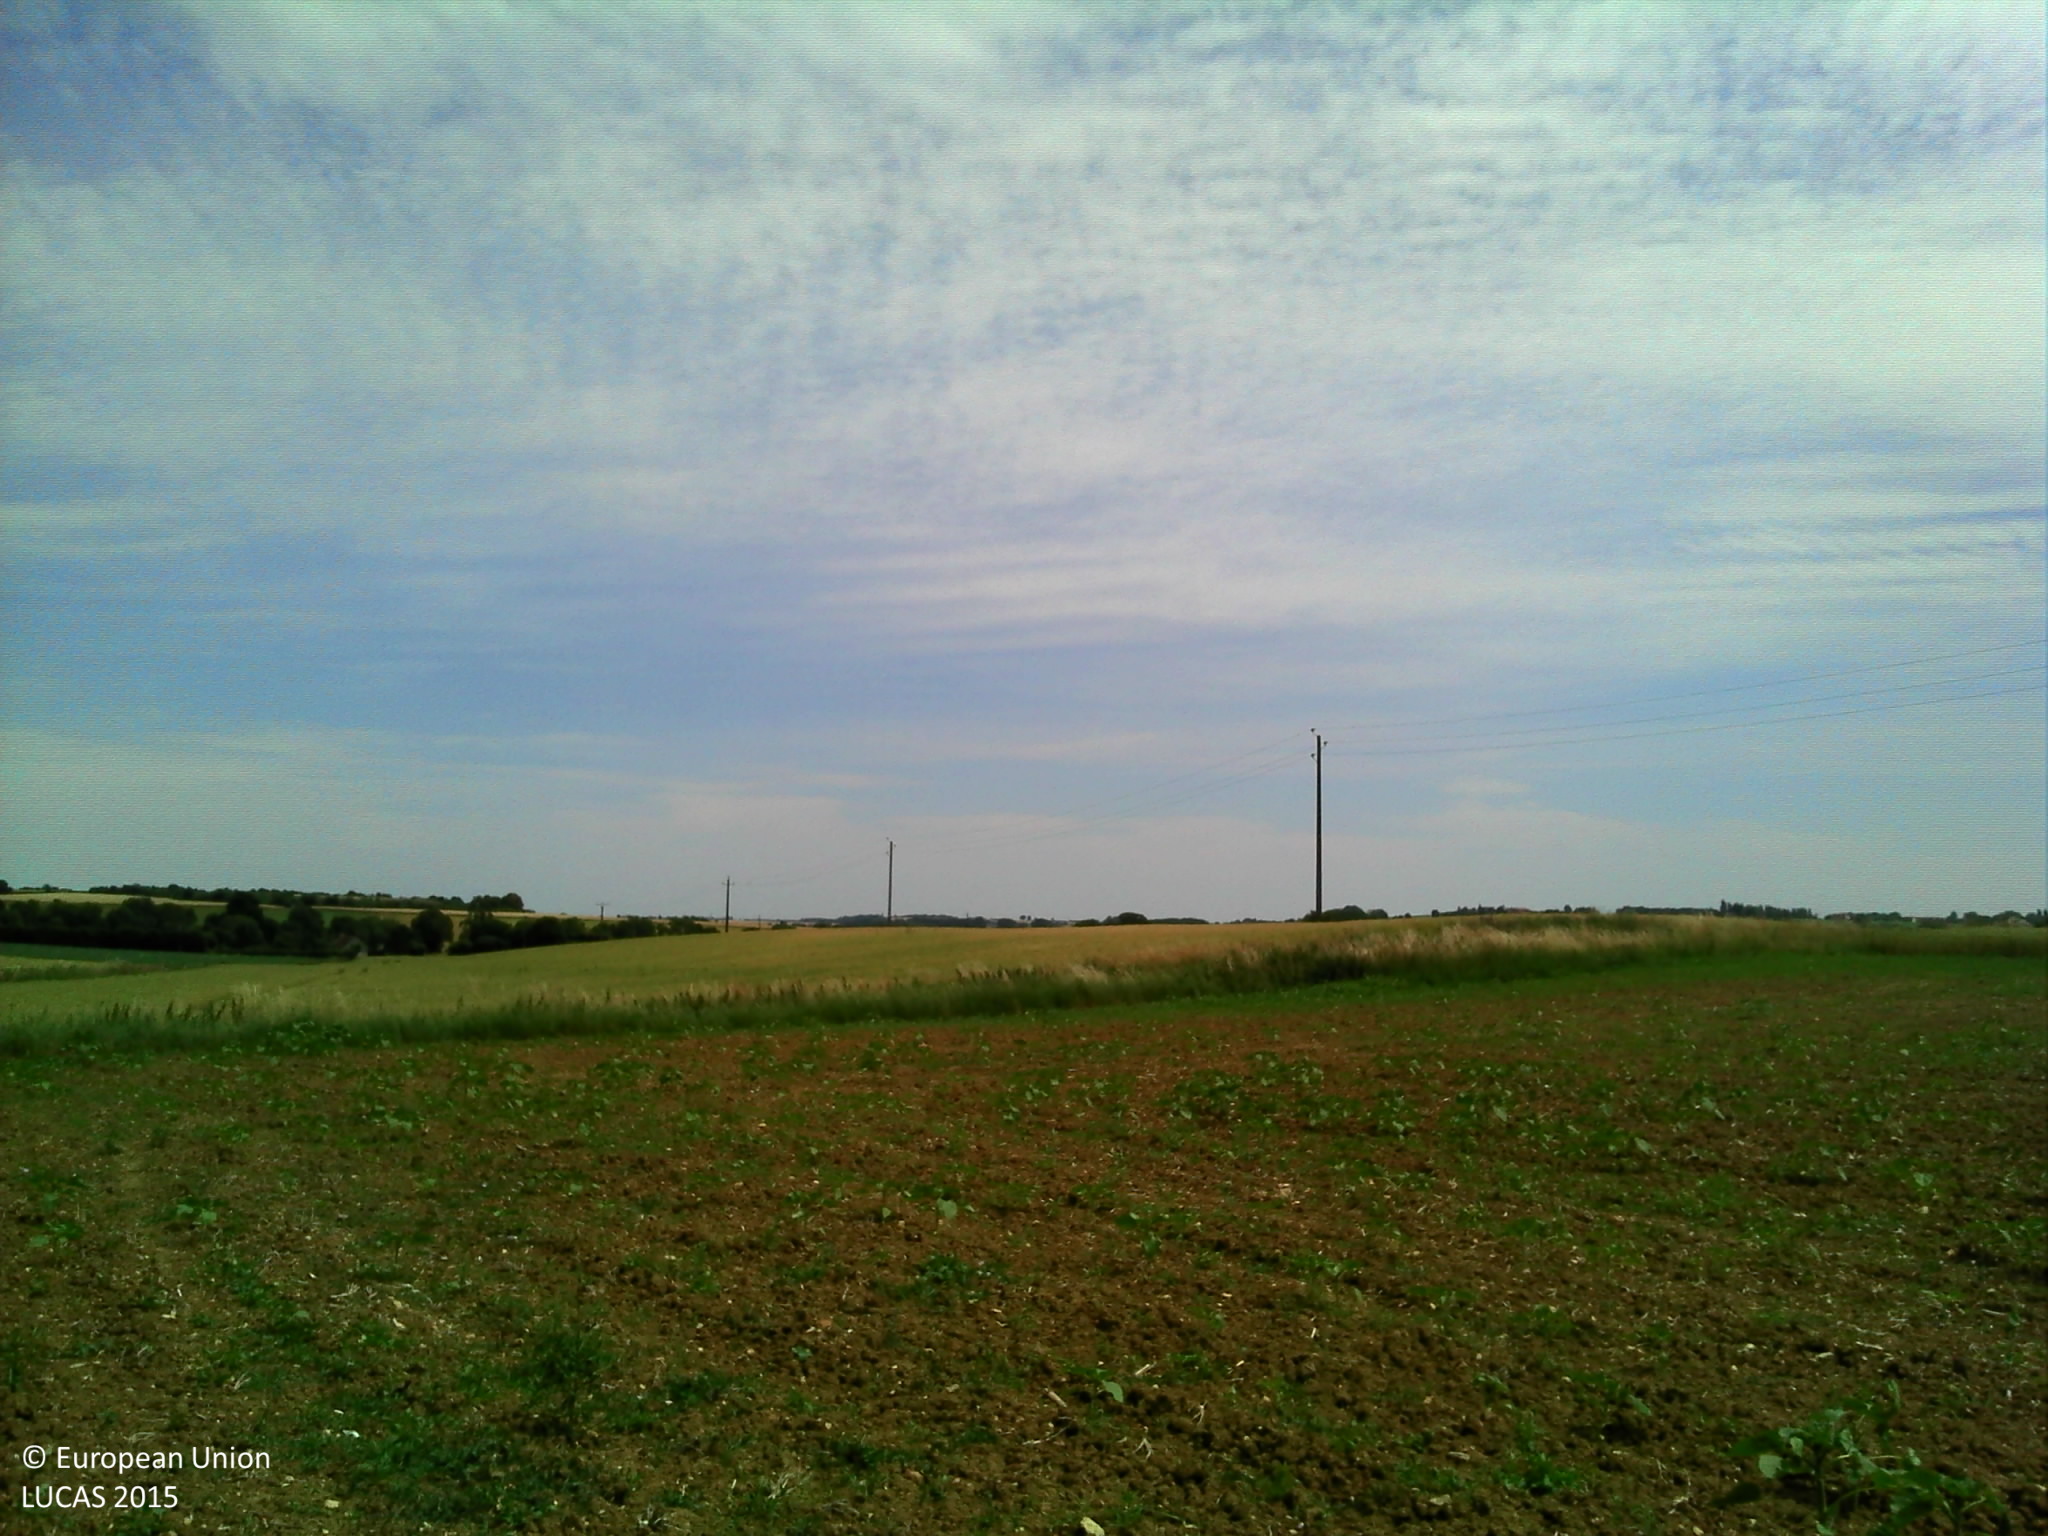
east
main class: Cropland
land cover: Sunflower
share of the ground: < 10 %
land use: Agriculture (excluding fallow land and kitchen gardens)
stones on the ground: > 50 %
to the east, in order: Sunflower; Ditches and canals; Grass margins; Tracks; Grass margins; Ditches and canals; Common wheat; Electric lines; Common wheat
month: June
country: FR
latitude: 48.3089
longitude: 0.1704
